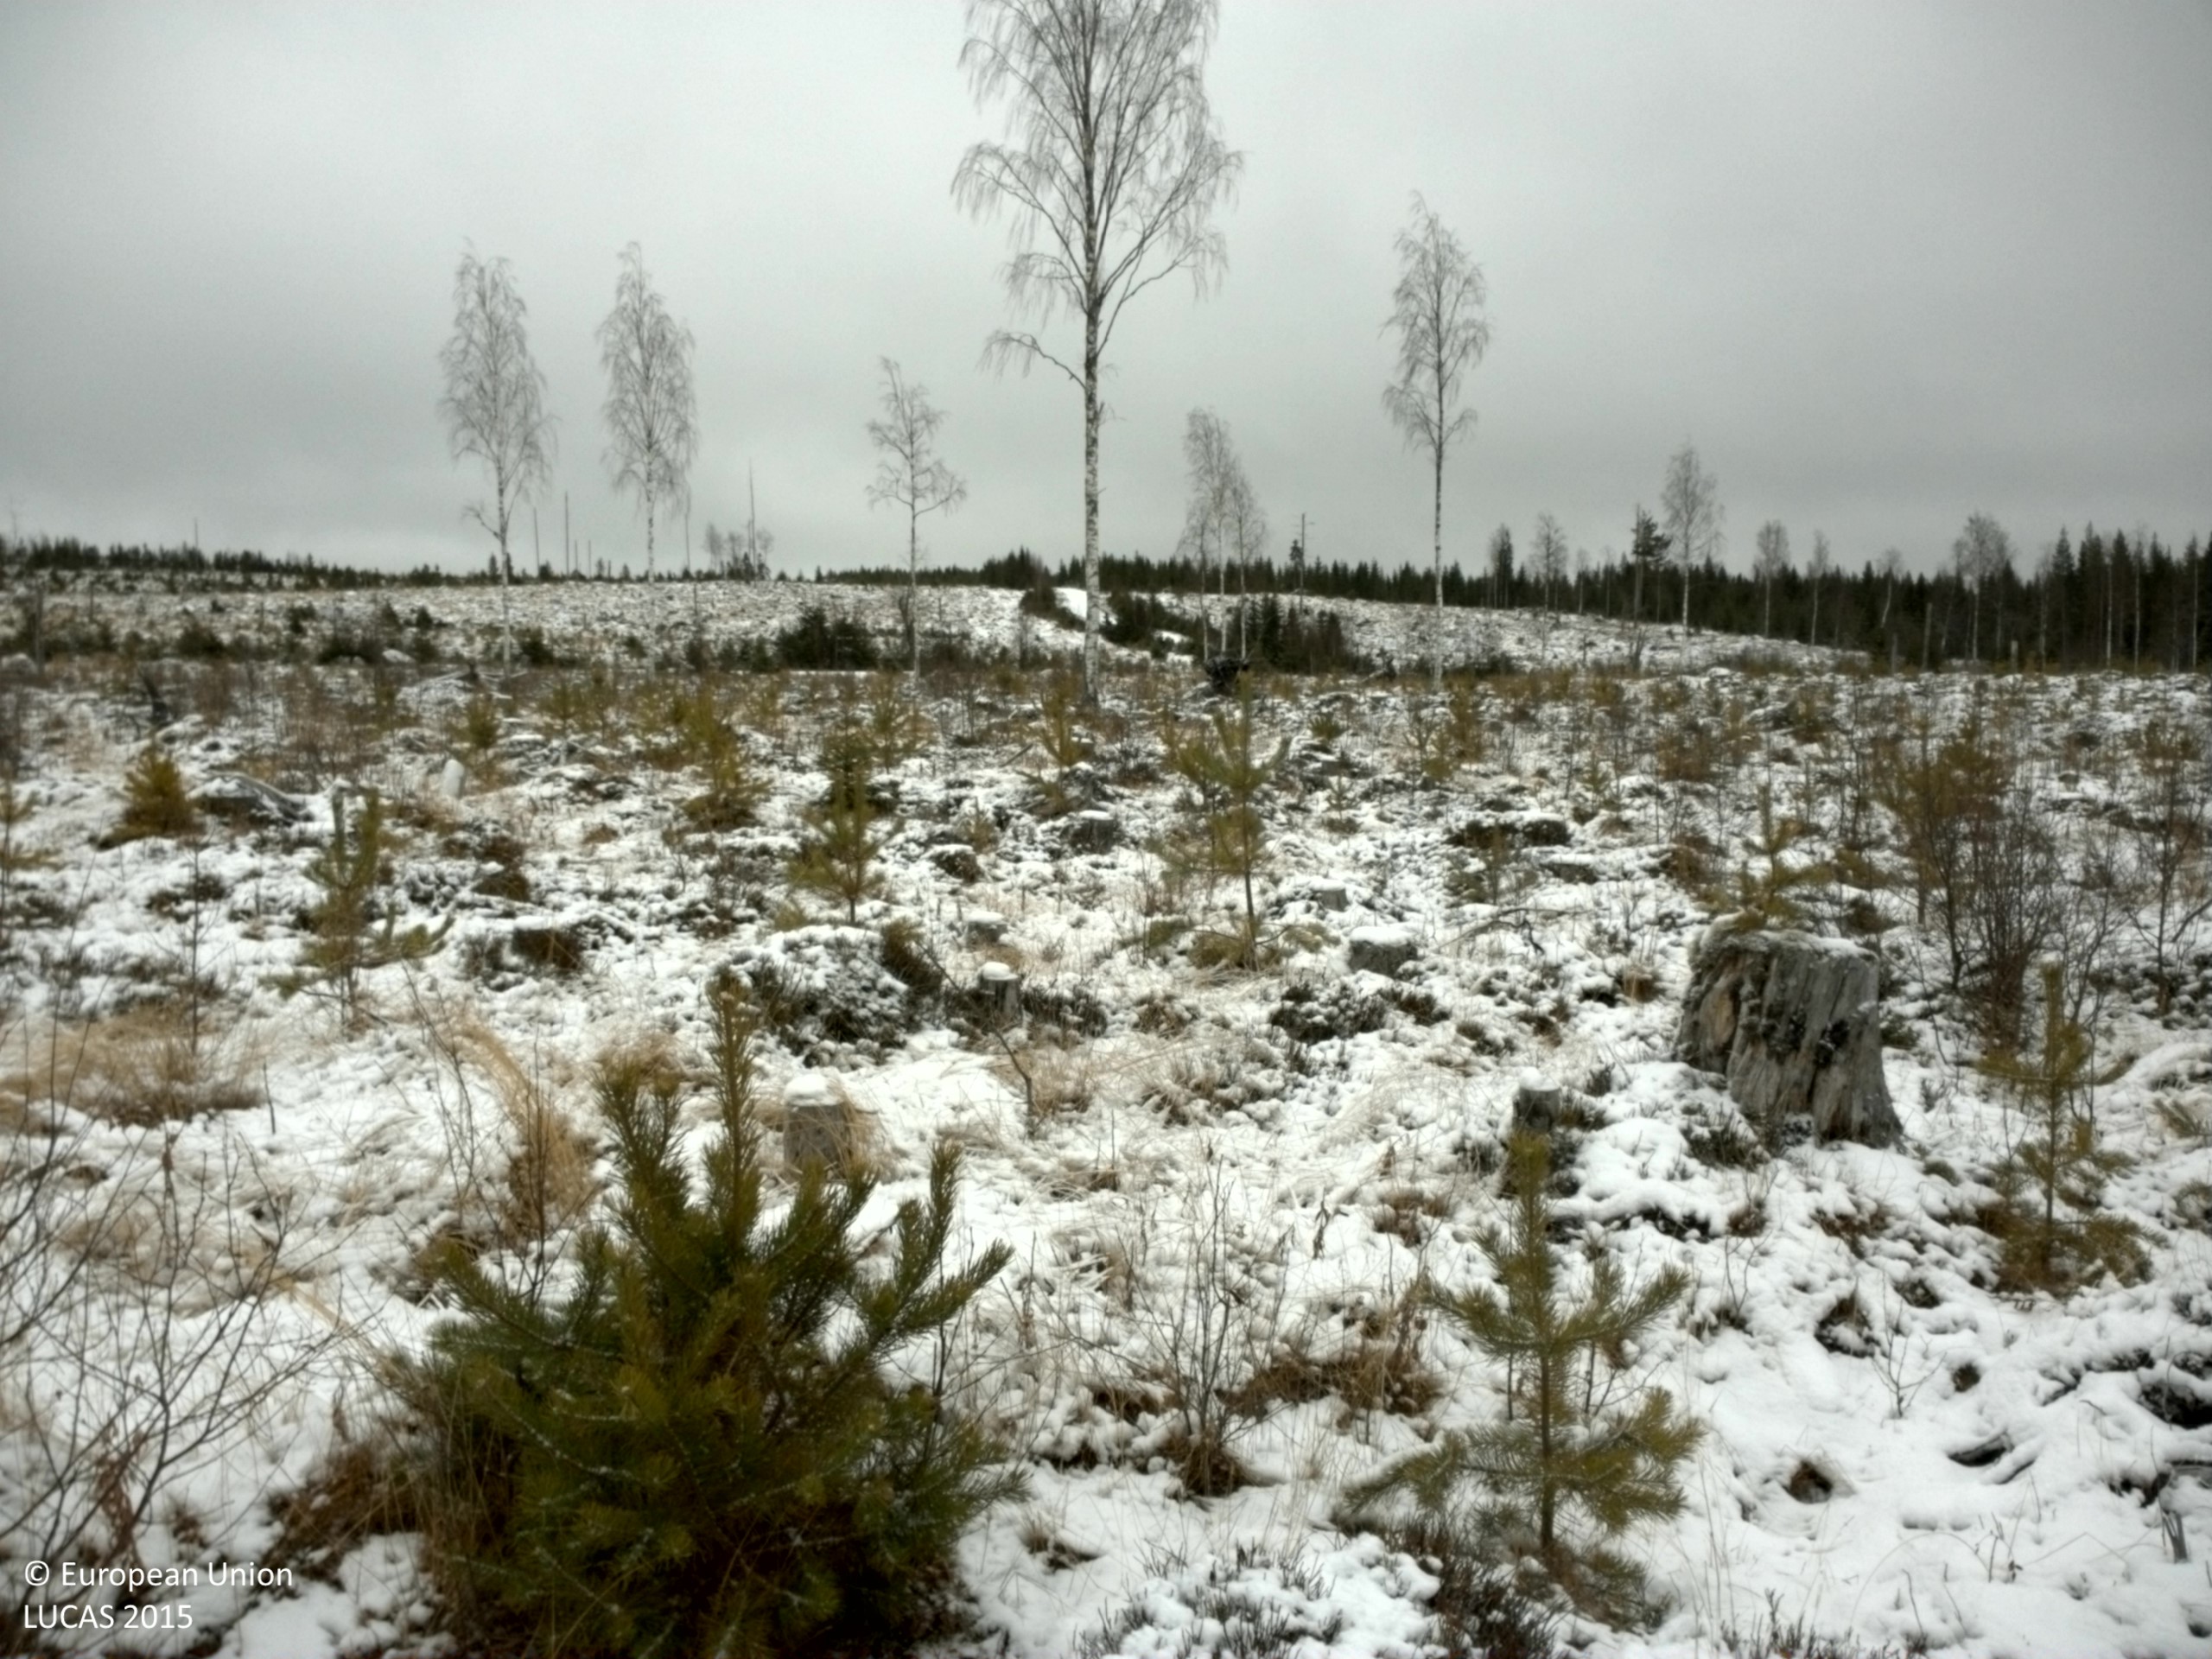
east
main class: Woodland
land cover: Pine dominated mixed woodland
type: boreal forest
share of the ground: 10 - 25 %
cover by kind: shrubs 50 %, lichens and mosses 25 %, coniferous forest trees 10 %, broadleaved forest trees 10 %, herbaceous plants 5 %
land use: Forestry
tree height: < 5 m
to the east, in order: Pine dominated mixed woodland; Spruce dominated mixed woodland; Paved roads, cycling and walking lanes; Spruce dominated mixed woodland; Pine dominated mixed woodland; Shrubland with sparse tree cover
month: November
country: SE
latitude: 61.8235
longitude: 15.5449
